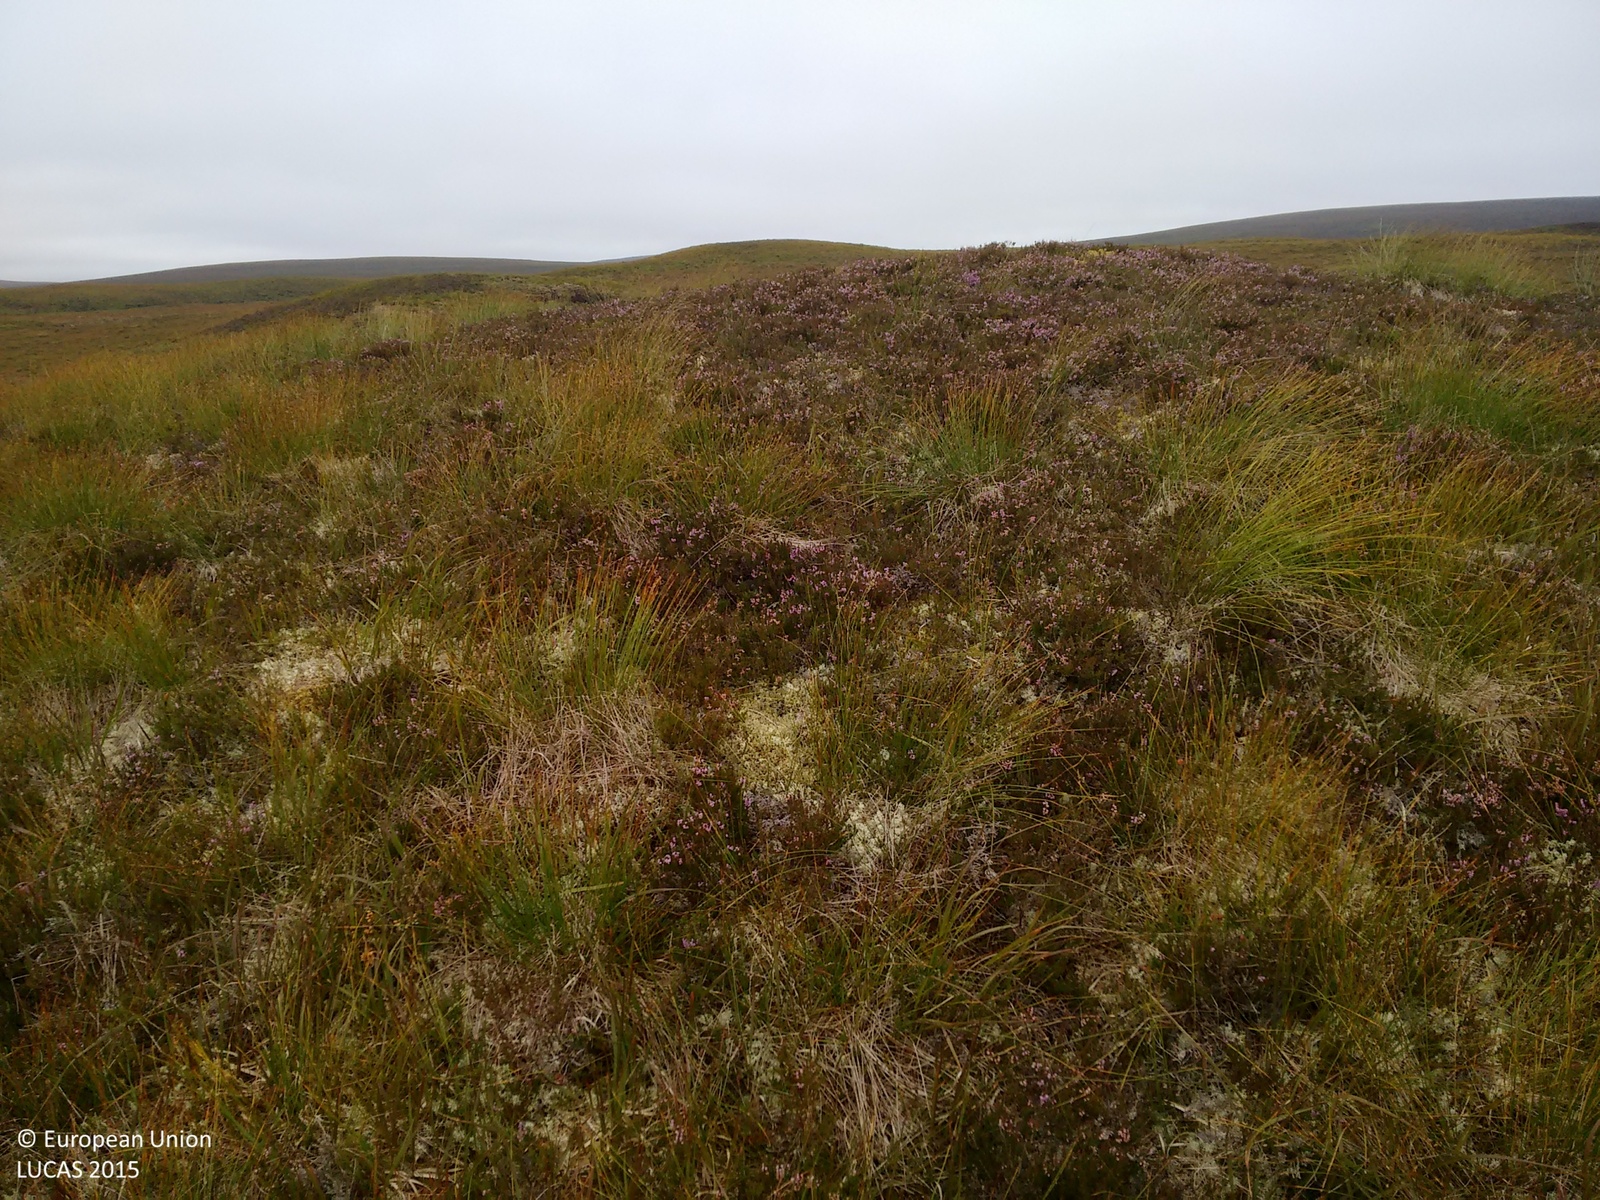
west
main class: Shrubland
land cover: Shrubland without tree cover
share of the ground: 50 - 75 %
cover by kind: shrubs 60 %, herbaceous plants 40 %
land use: Semi-natural and natural areas not in use
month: September
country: GB
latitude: 58.1935
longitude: -4.5301
